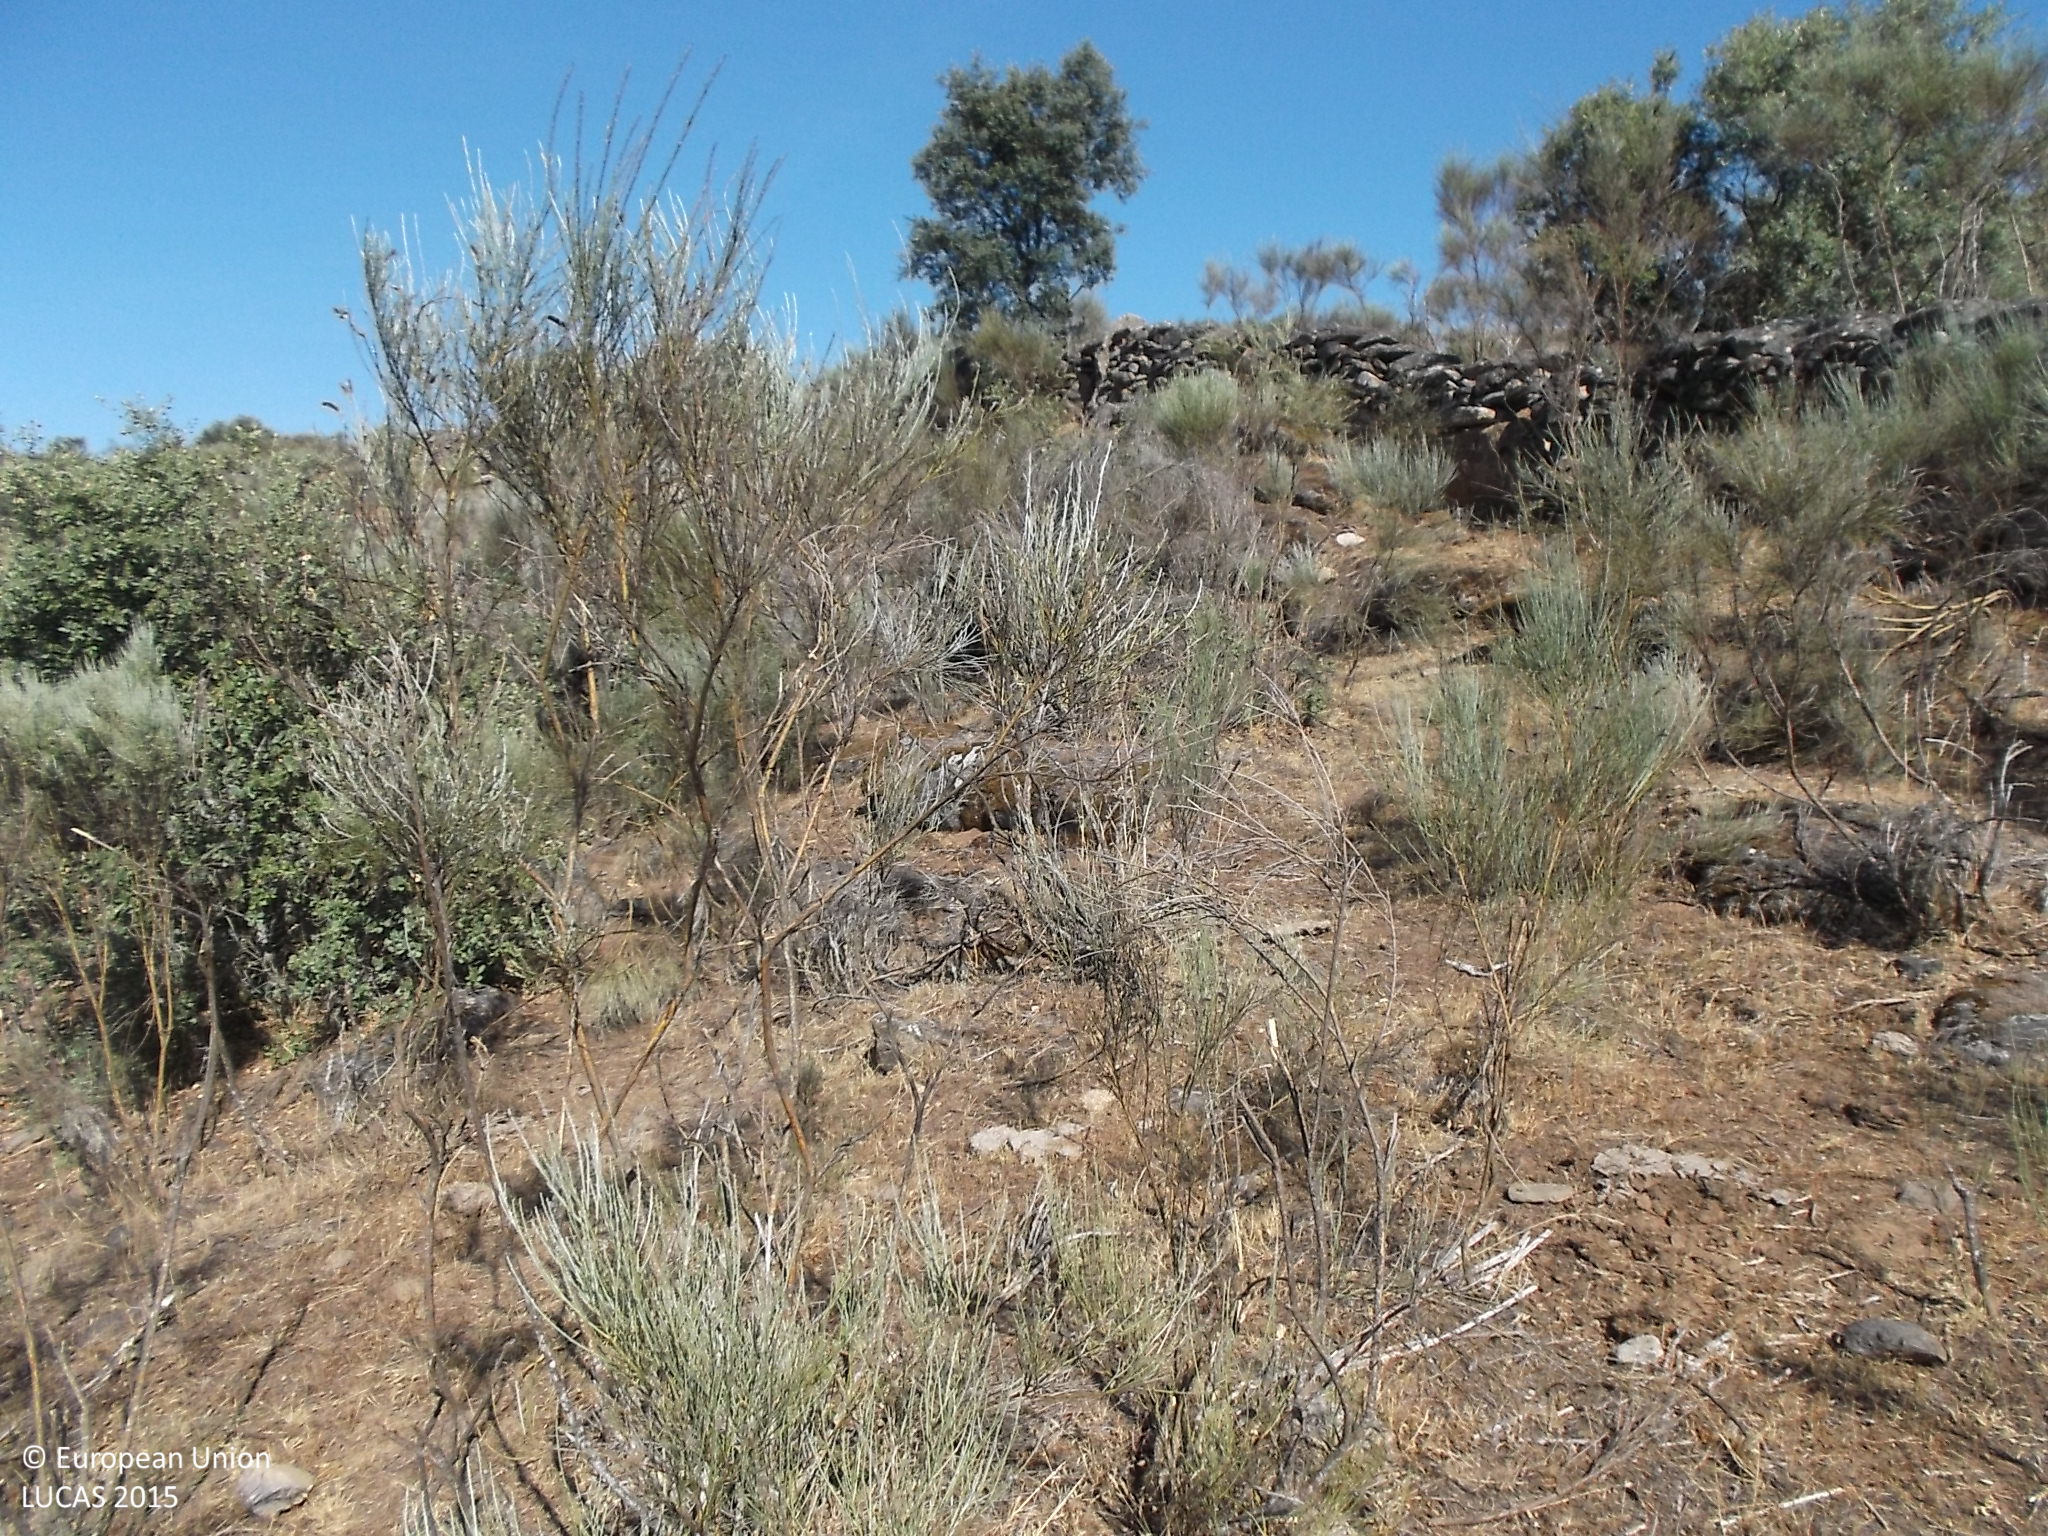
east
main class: Shrubland
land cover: Shrubland without tree cover
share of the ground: > 75 %
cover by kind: shrubs 90 %, consolidated bare surface 10 %
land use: Agriculture (excluding fallow land and kitchen gardens)
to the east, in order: Shrubland without tree cover; Dry stone walls; Shrubland without tree cover; Fences; Shrubland without tree cover; Dry stone walls; Shrubland without tree cover; Dry stone walls; Shrubland without tree cover; Dry stone walls; Shrubland without tree cover
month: July
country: ES
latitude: 40.8188
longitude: -6.7803
